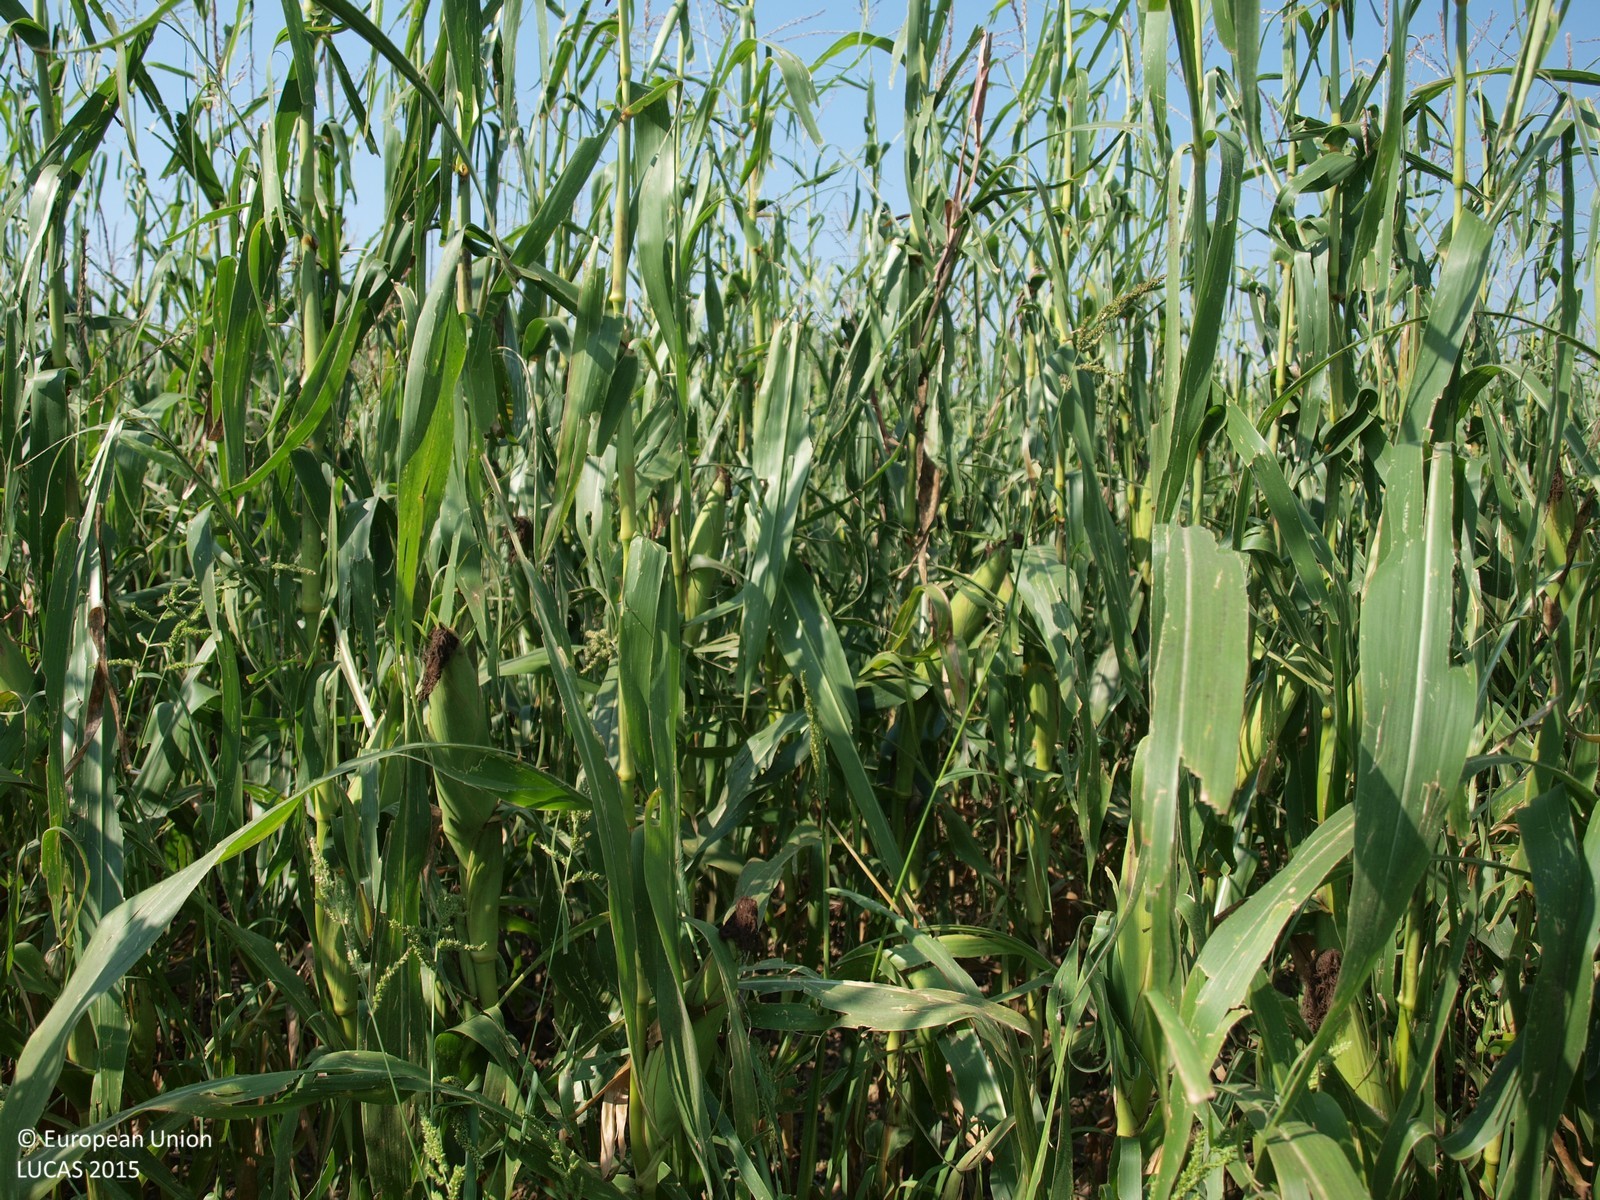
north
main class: Cropland
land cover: Maize
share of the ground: > 75 %
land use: Agriculture (excluding fallow land and kitchen gardens)
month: August
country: HR
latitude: 45.9067
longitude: 16.6903
